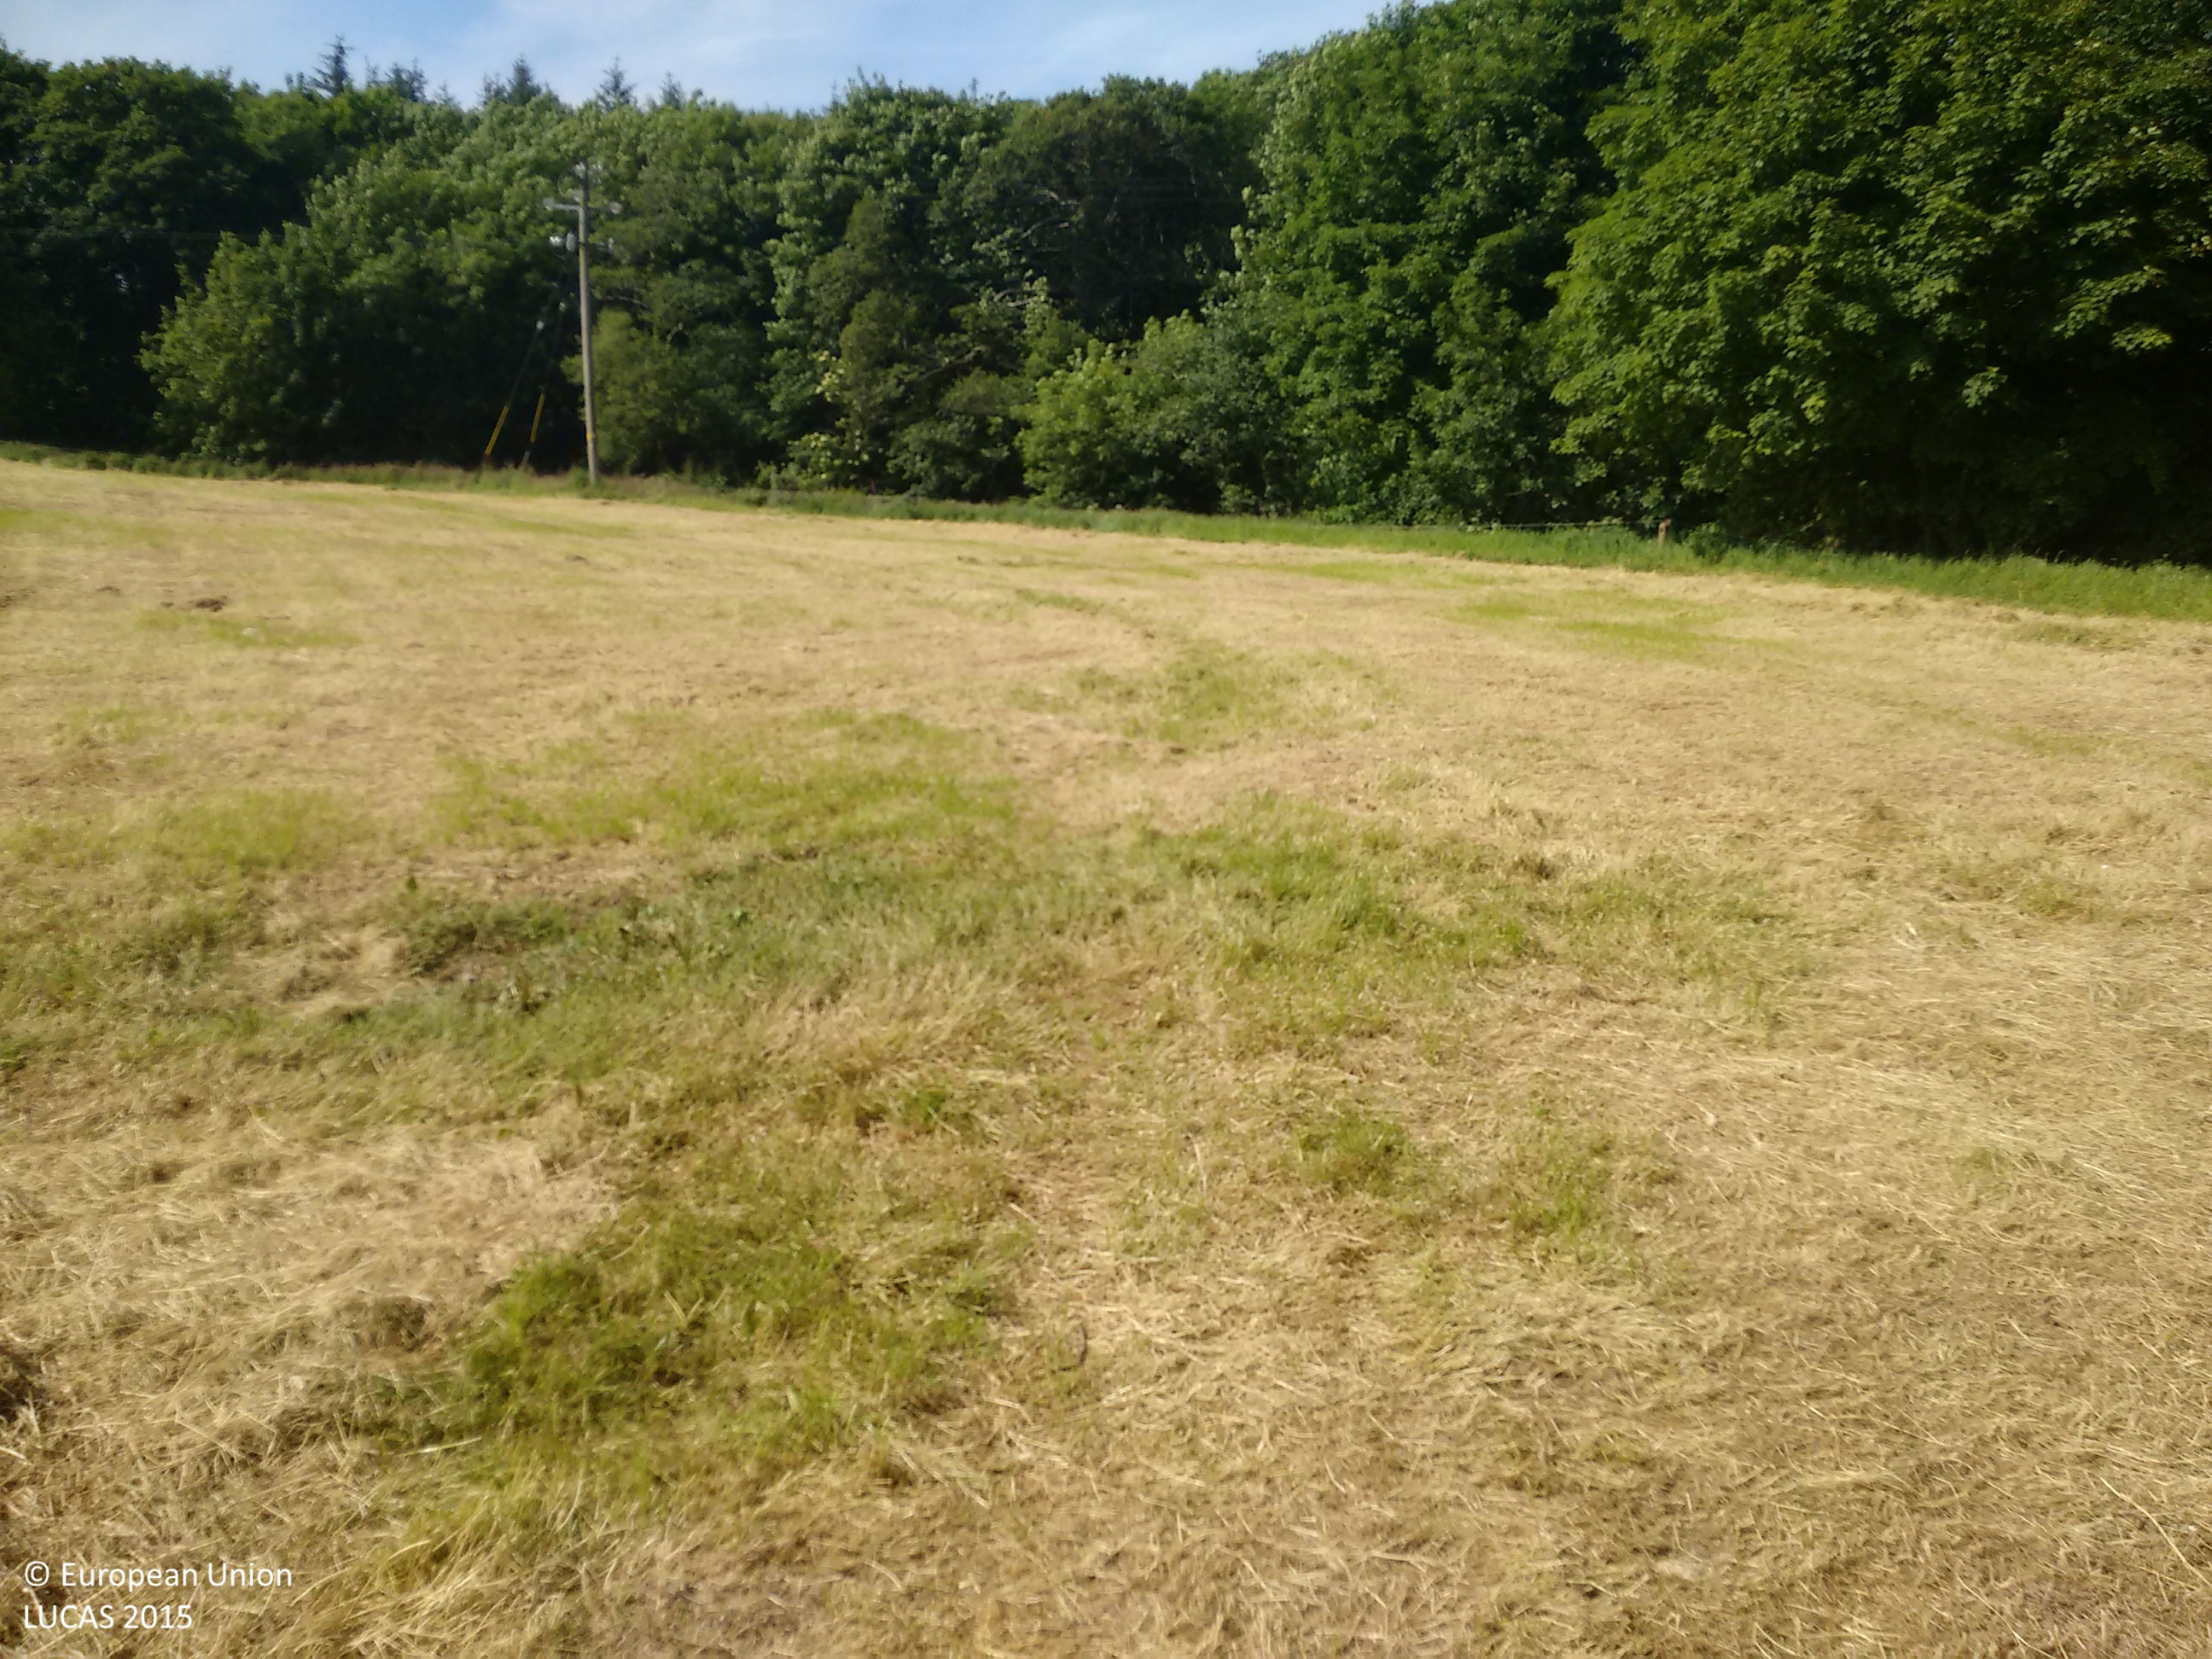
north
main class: Grassland
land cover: Grassland without tree/shrub cover
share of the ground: > 75 %
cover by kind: herbaceous plants 100 %
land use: Agriculture (excluding fallow land and kitchen gardens)
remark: Harvested field
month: June
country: IE
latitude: 51.9443
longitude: -7.9970
